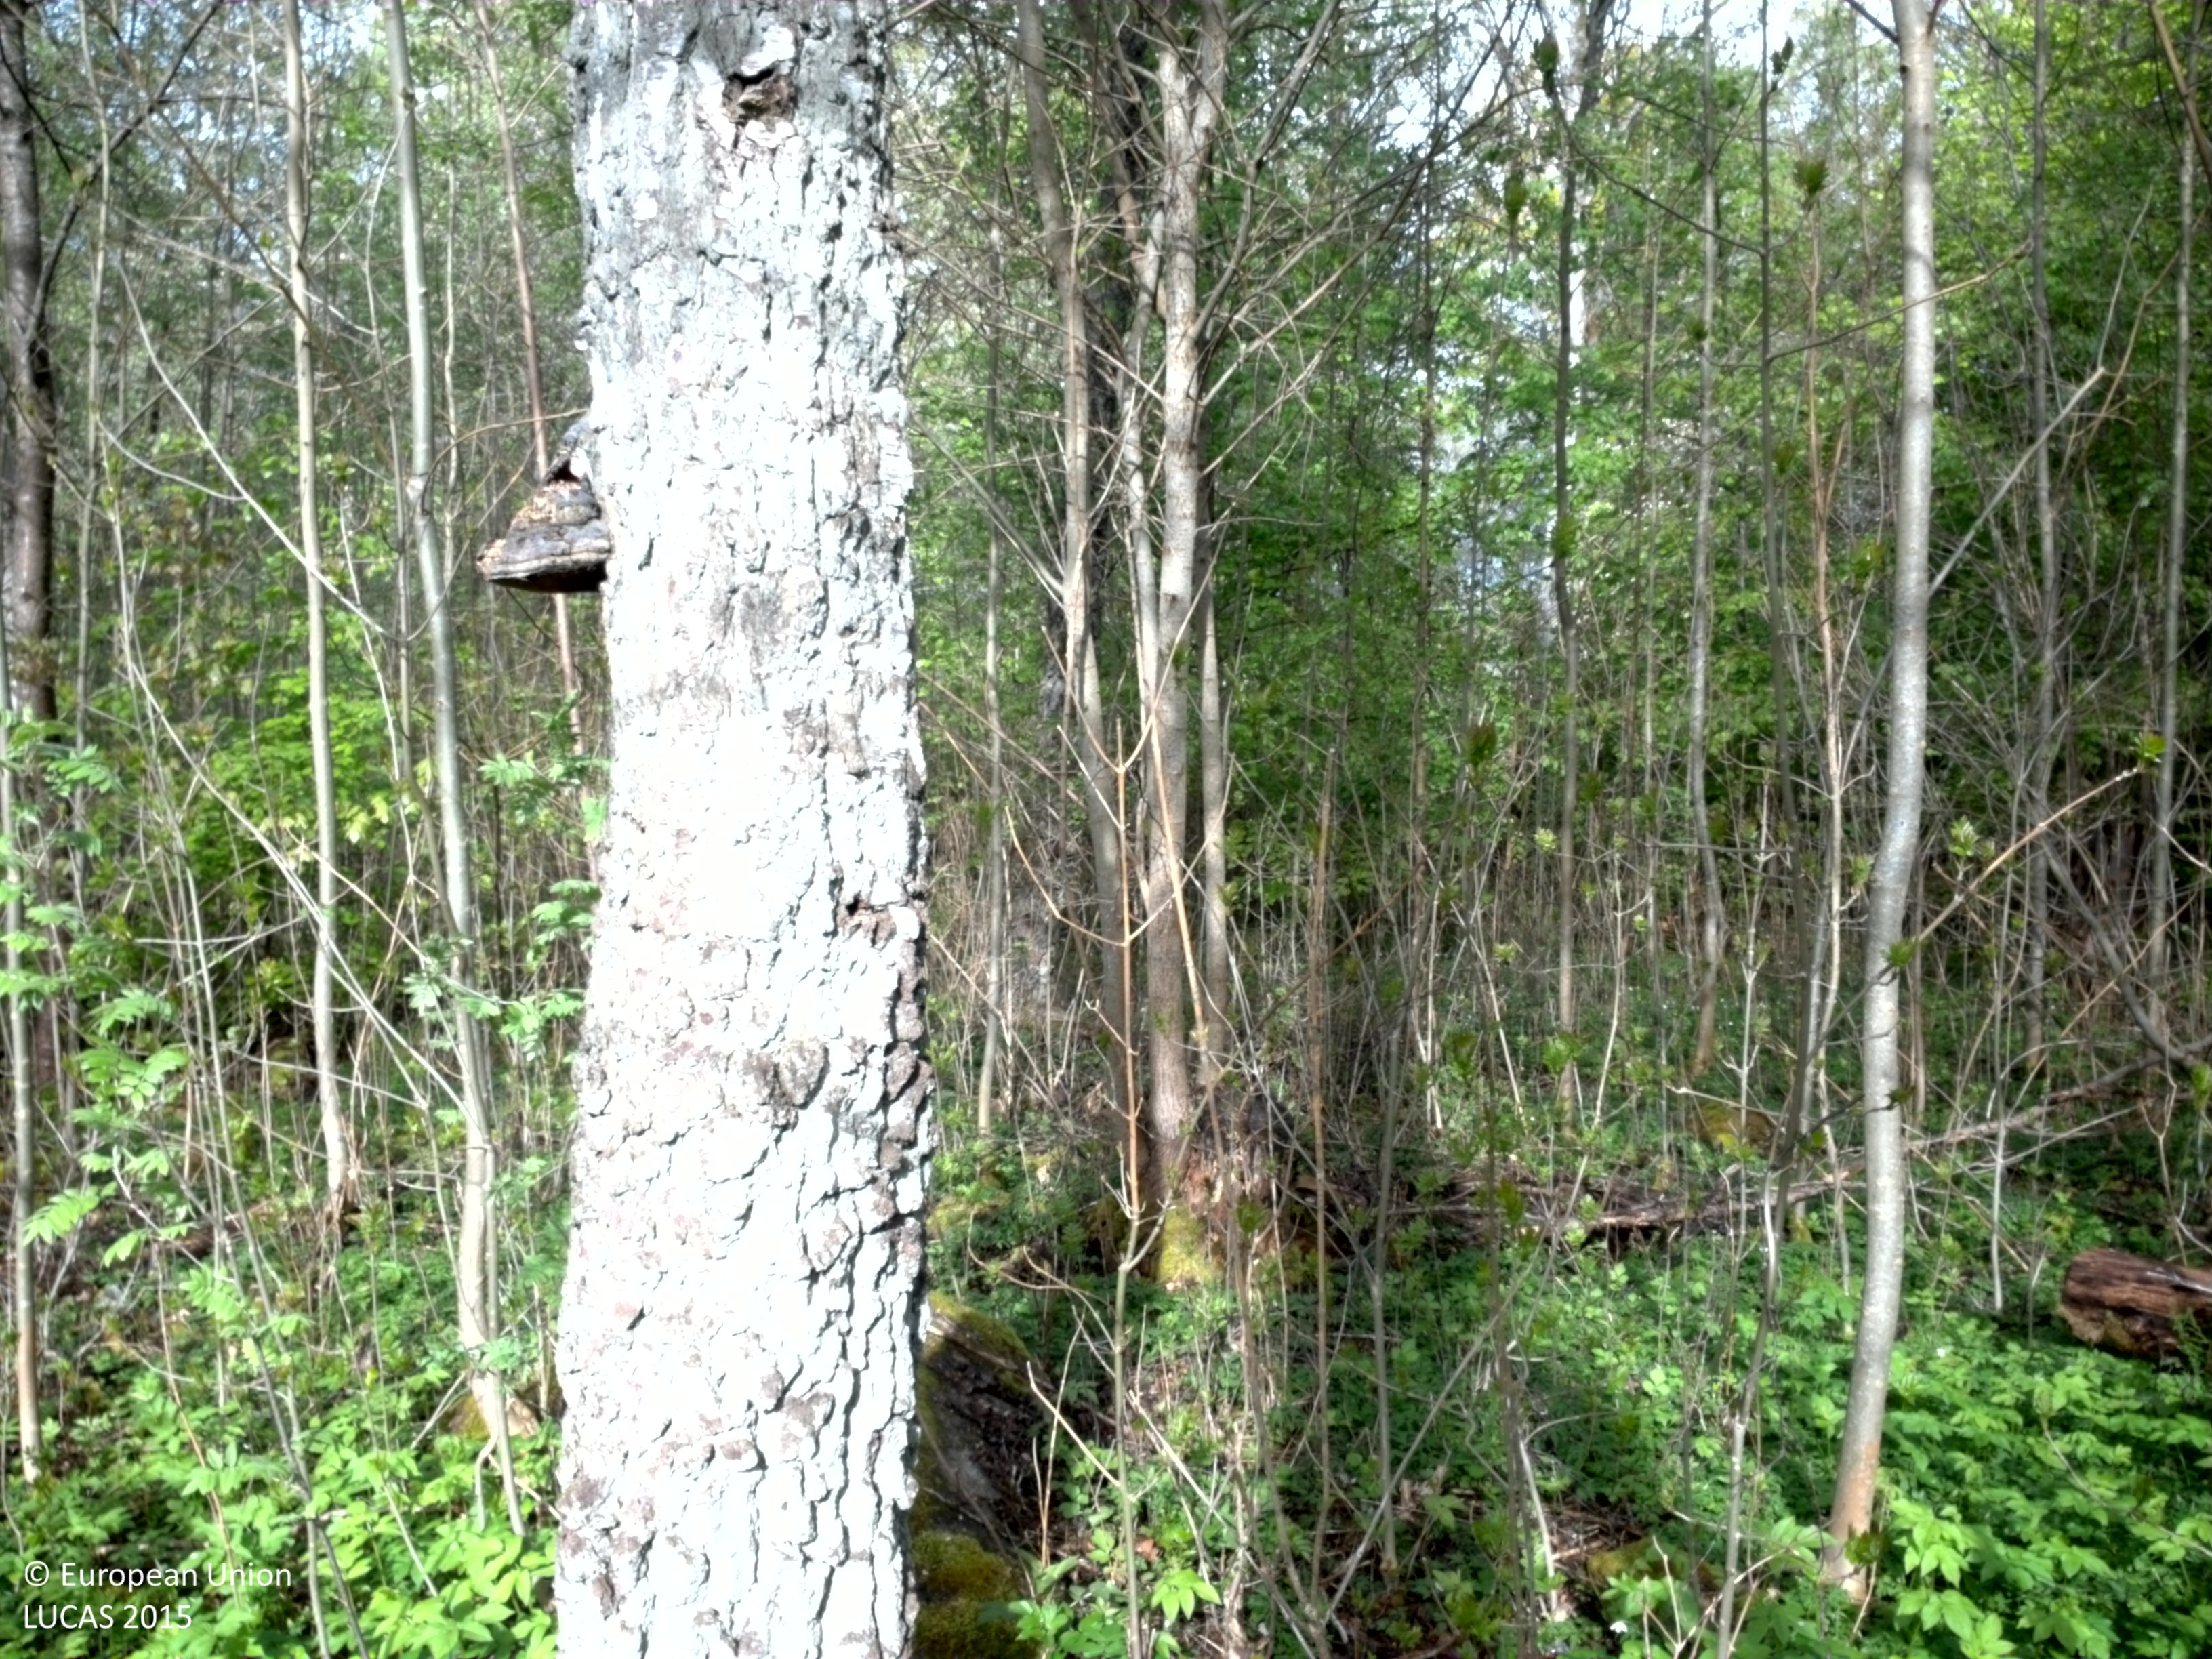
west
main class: Woodland
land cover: Broadleaved woodland
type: boreal forest
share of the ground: 50 - 75 %
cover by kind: broadleaved forest trees 60 %, herbaceous plants 20 %, lichens and mosses 20 %
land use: Amenities, museums, leisure
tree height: > 5 m
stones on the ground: < 10 %
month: May
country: SE
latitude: 56.8545
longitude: 14.8020
